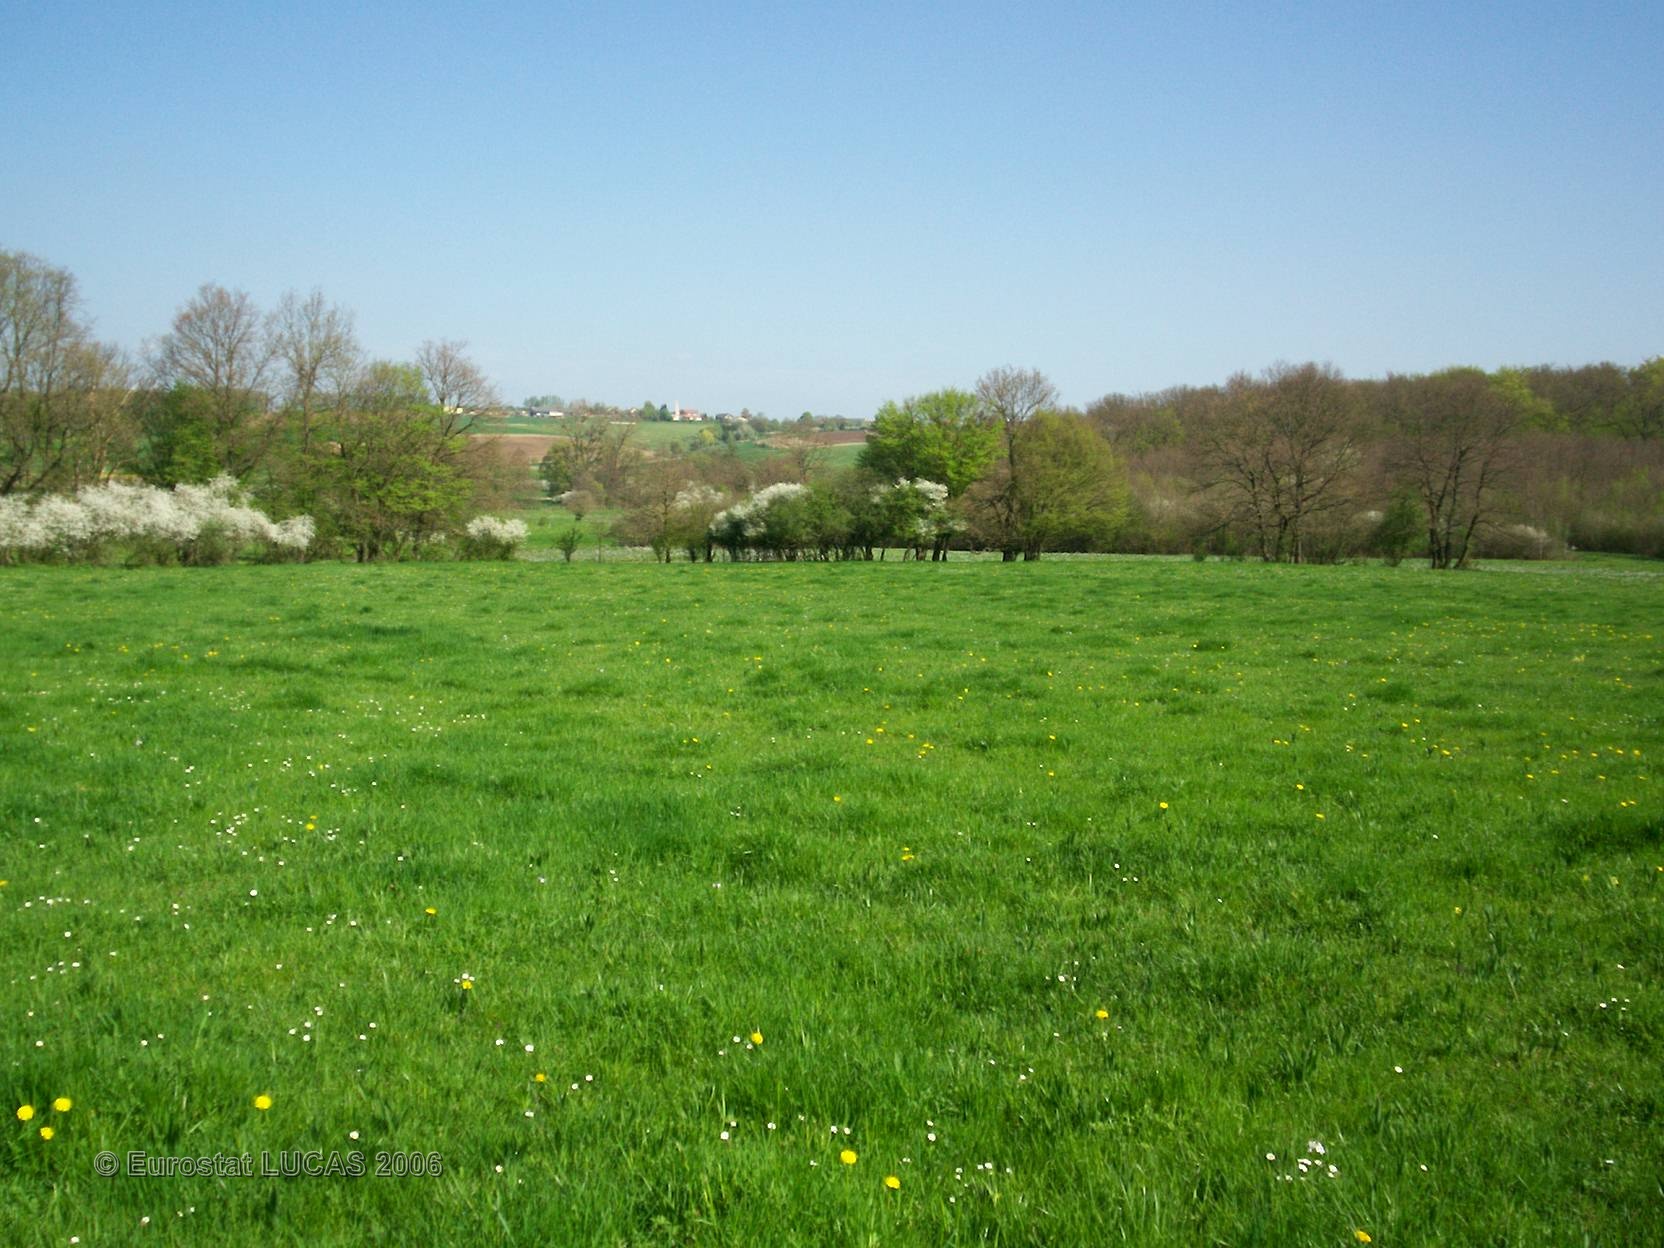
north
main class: Grassland
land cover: Grassland without tree/shrub cover
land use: Agriculture (excluding fallow land and kitchen gardens)
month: April
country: FR
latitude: 49.0582
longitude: 6.7570
